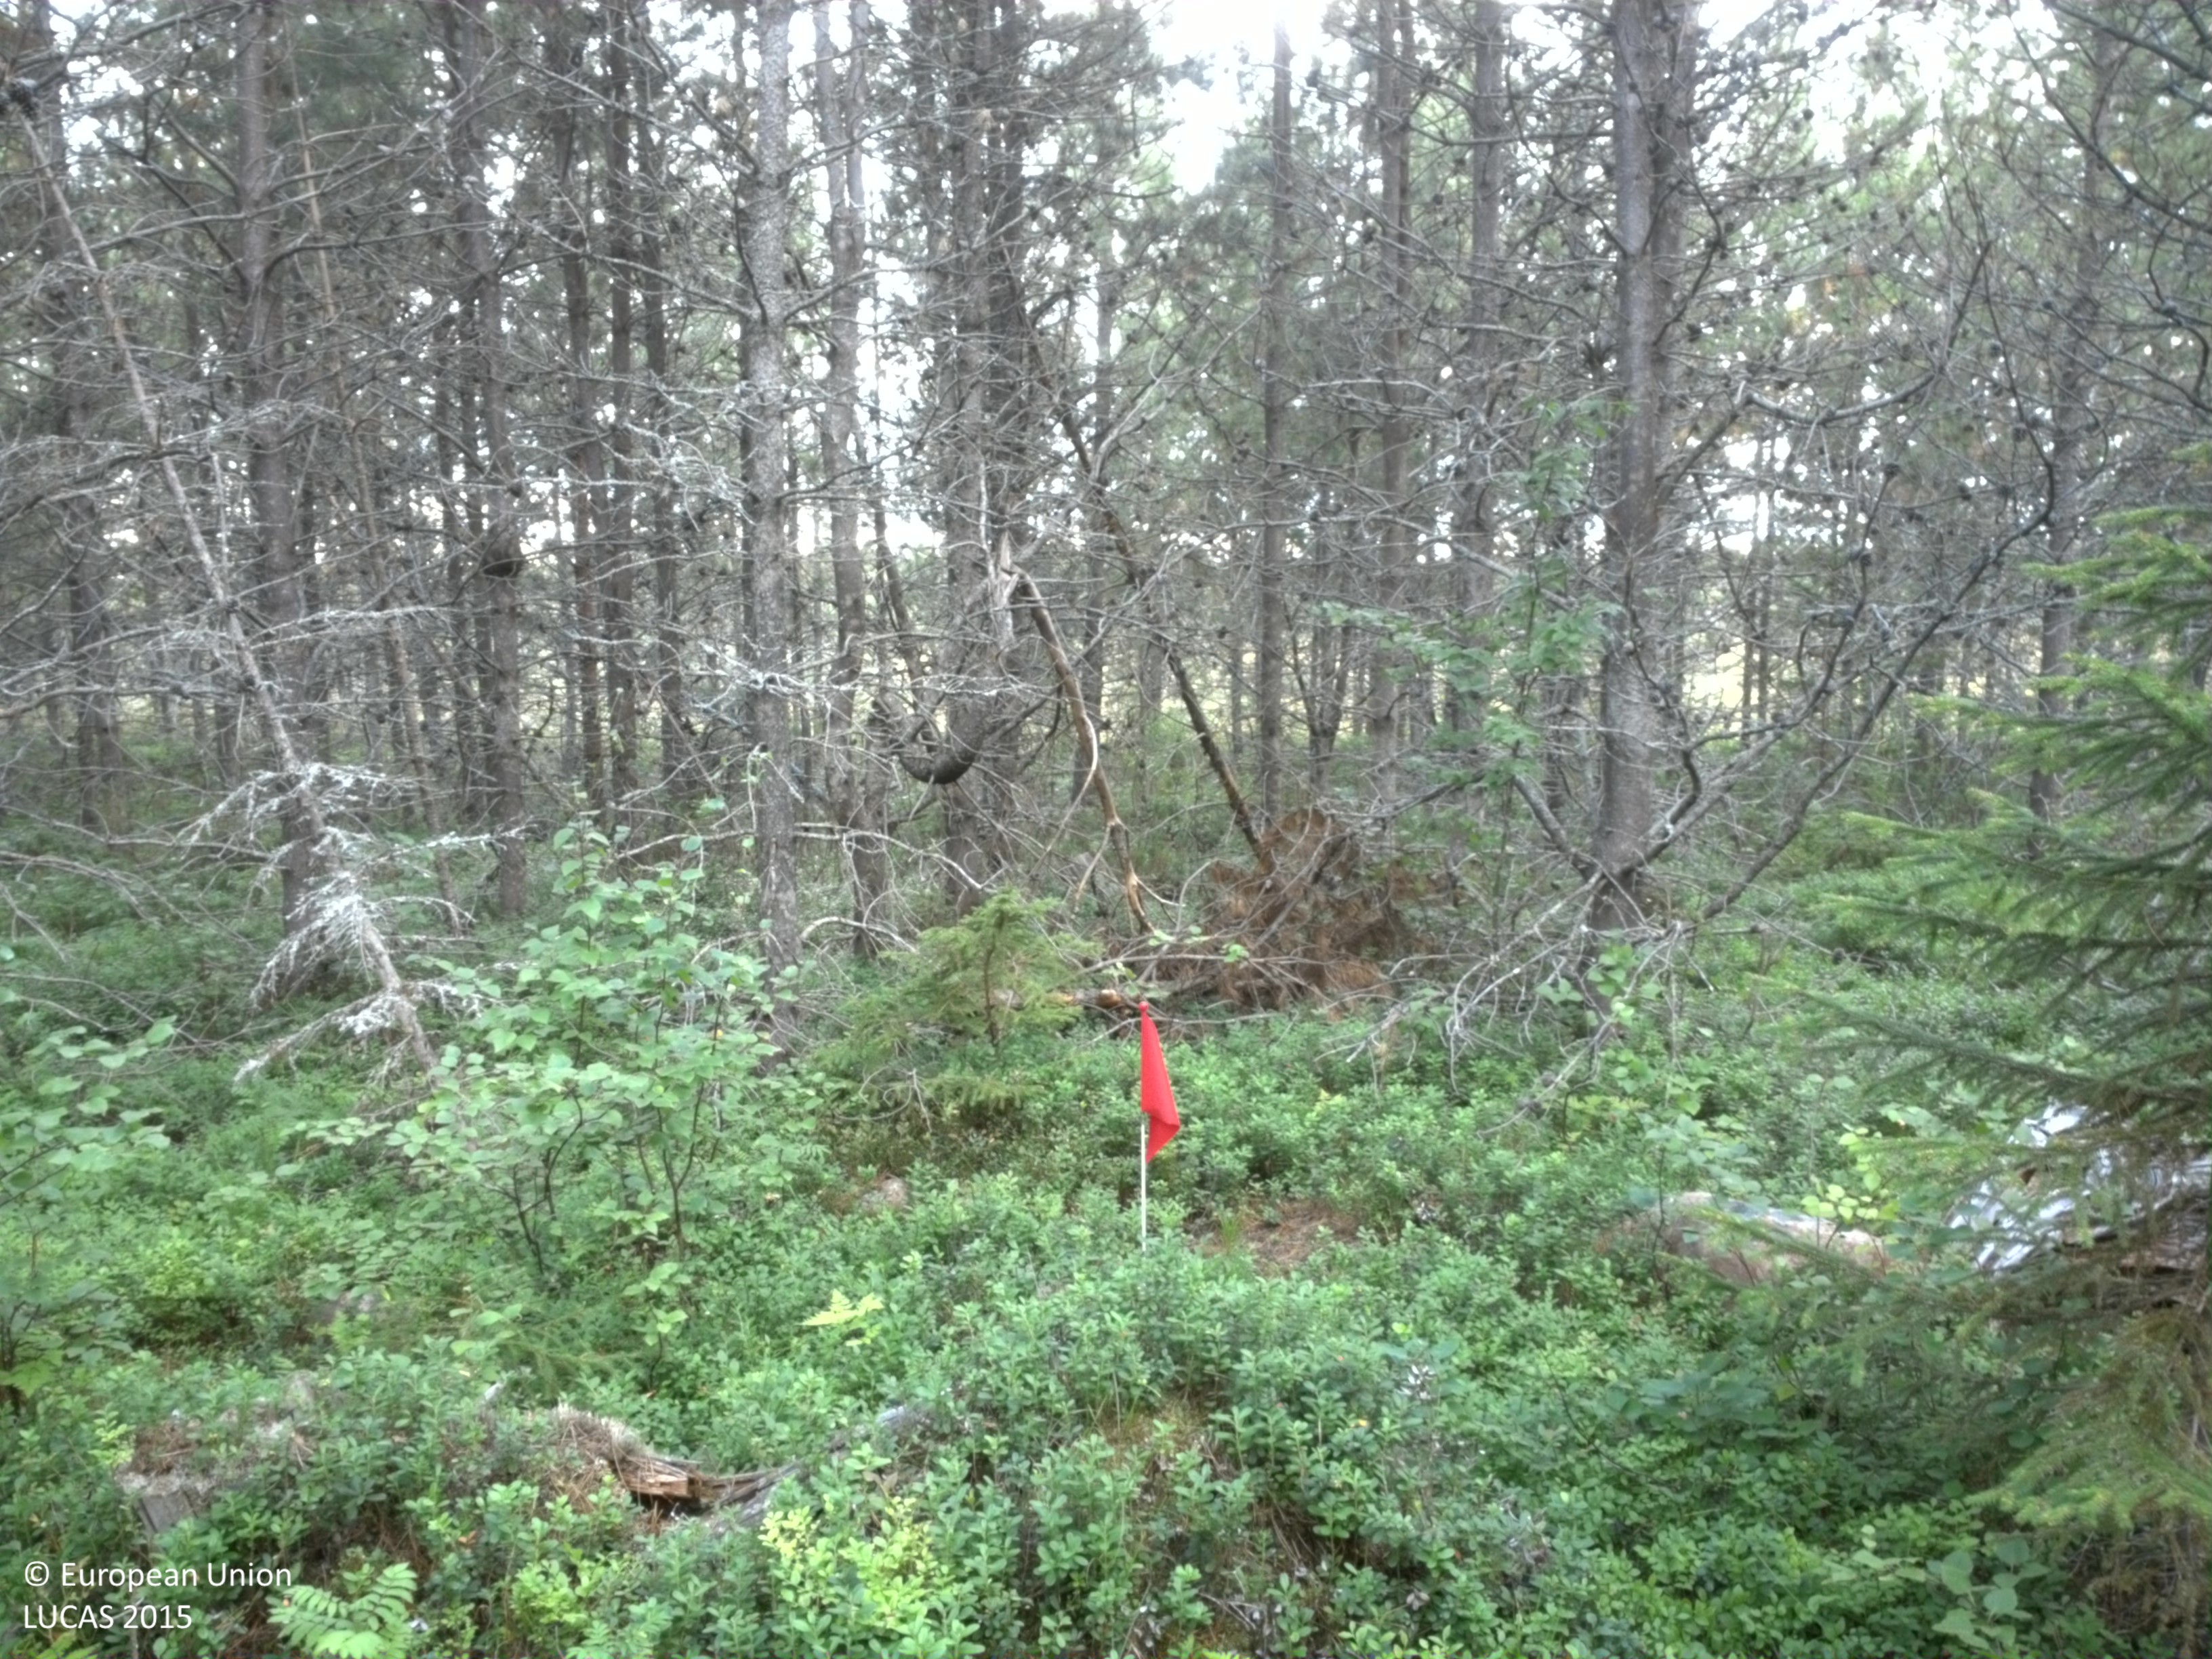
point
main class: Woodland
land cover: Pine dominated coniferous woodland
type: exotic forest
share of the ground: 50 - 75 %
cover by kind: coniferous forest trees 70 %, shrubs 30 %
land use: Forestry
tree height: > 5 m
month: August
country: SE
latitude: 64.1800
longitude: 20.4542
